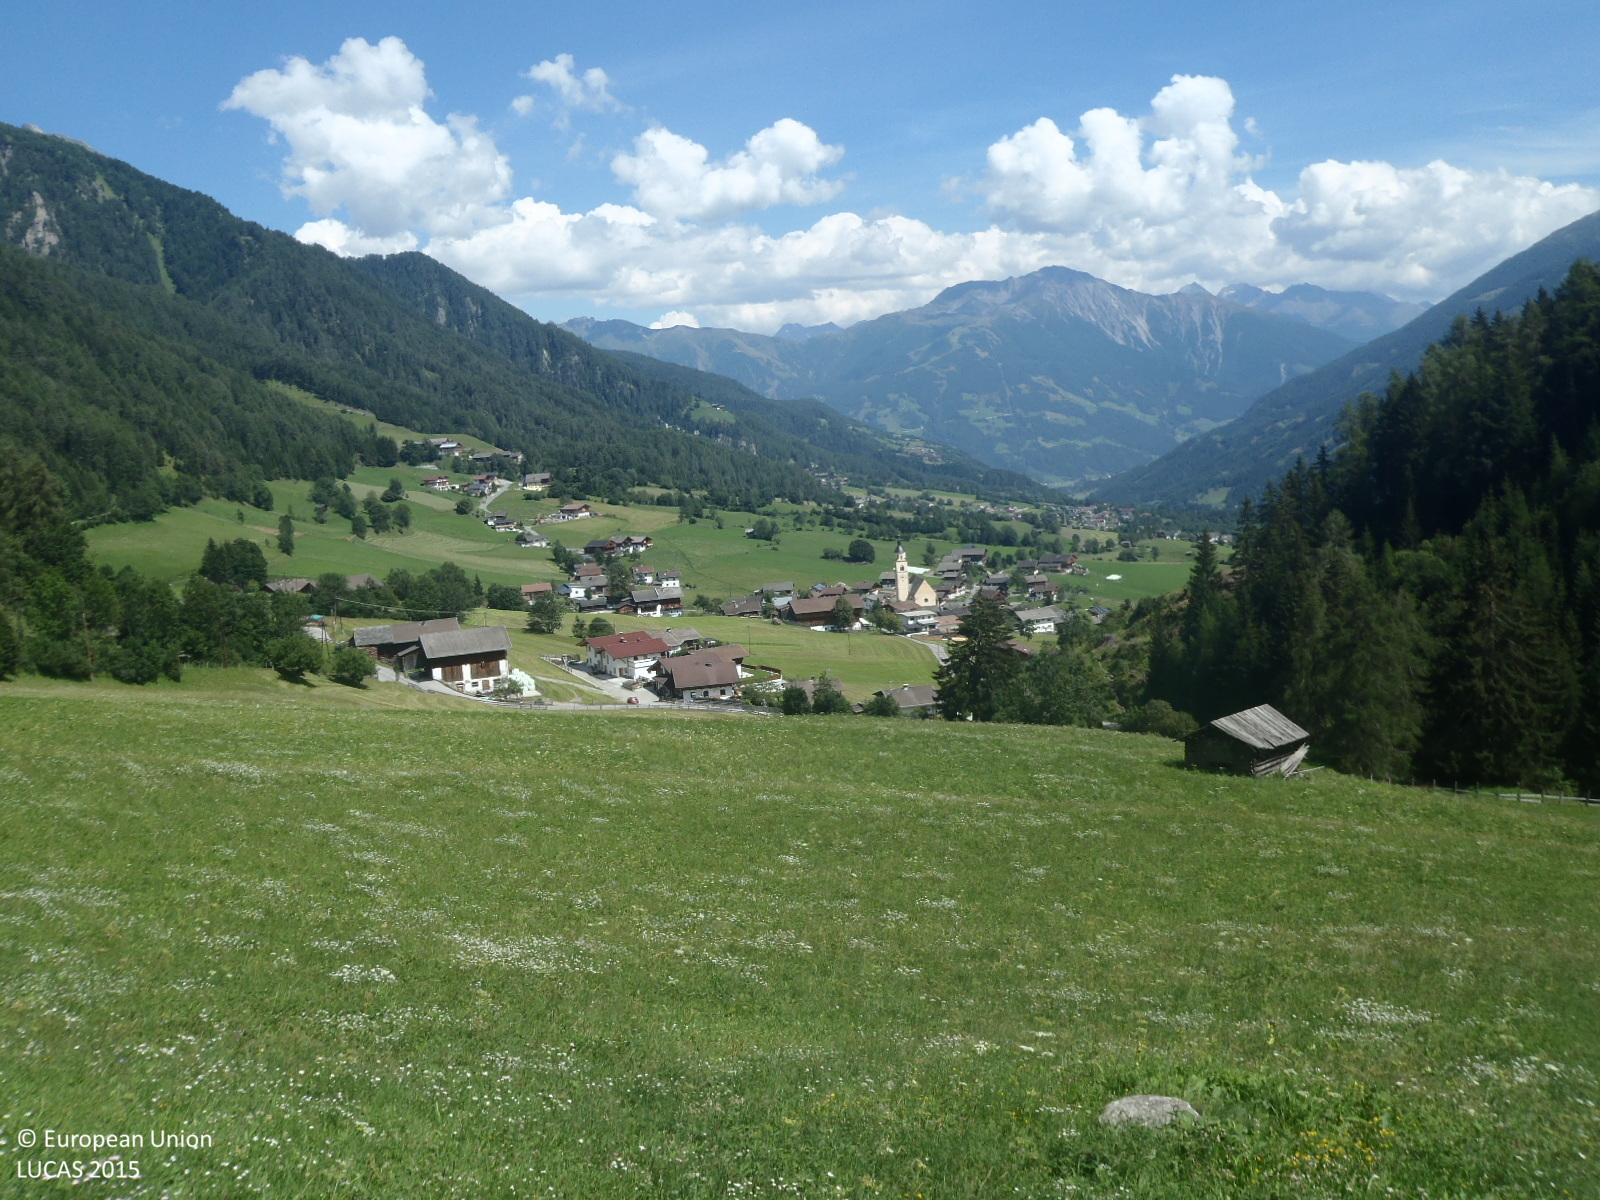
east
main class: Grassland
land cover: Grassland without tree/shrub cover
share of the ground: > 75 %
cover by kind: herbaceous plants 100 %
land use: Agriculture (excluding fallow land and kitchen gardens)
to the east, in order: Grassland without tree/shrub cover
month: August
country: AT
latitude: 47.0082
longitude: 12.4312
